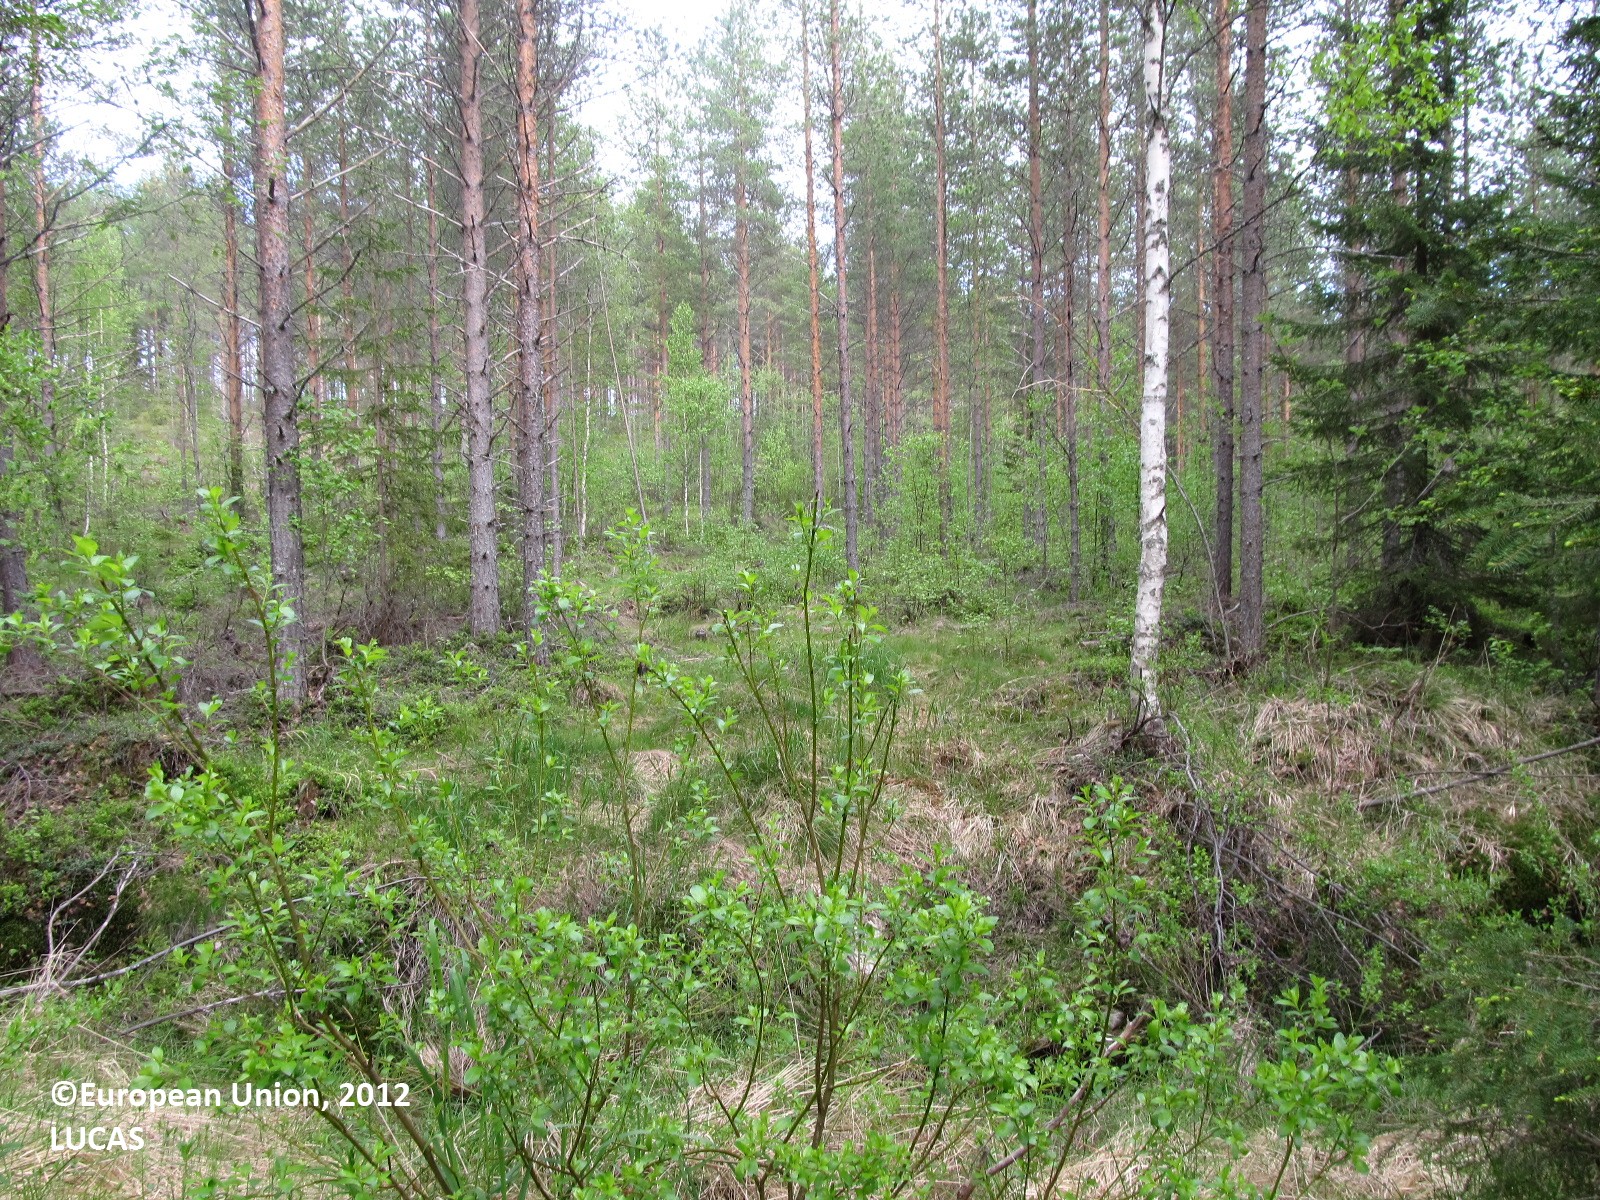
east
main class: Woodland
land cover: Pine dominated mixed woodland
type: boreal forest
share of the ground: 25 - 50 %
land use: Forestry
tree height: > 5 m
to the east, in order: Pine dominated mixed woodland; Grassland with sparse tree/shrub cover; Ditches and canals; Grassland with sparse tree/shrub cover; Pine dominated coniferous woodland; Grassland with sparse tree/shrub cover; Paved roads, cycling and walking lanes; Ditches and canals; Pine dominated coniferous woodland; Grassland with sparse tree/shrub cover; Pine dominated coniferous woodland; Spruce dominated coniferous woodland
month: June
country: FI
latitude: 63.2274
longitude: 29.1814
